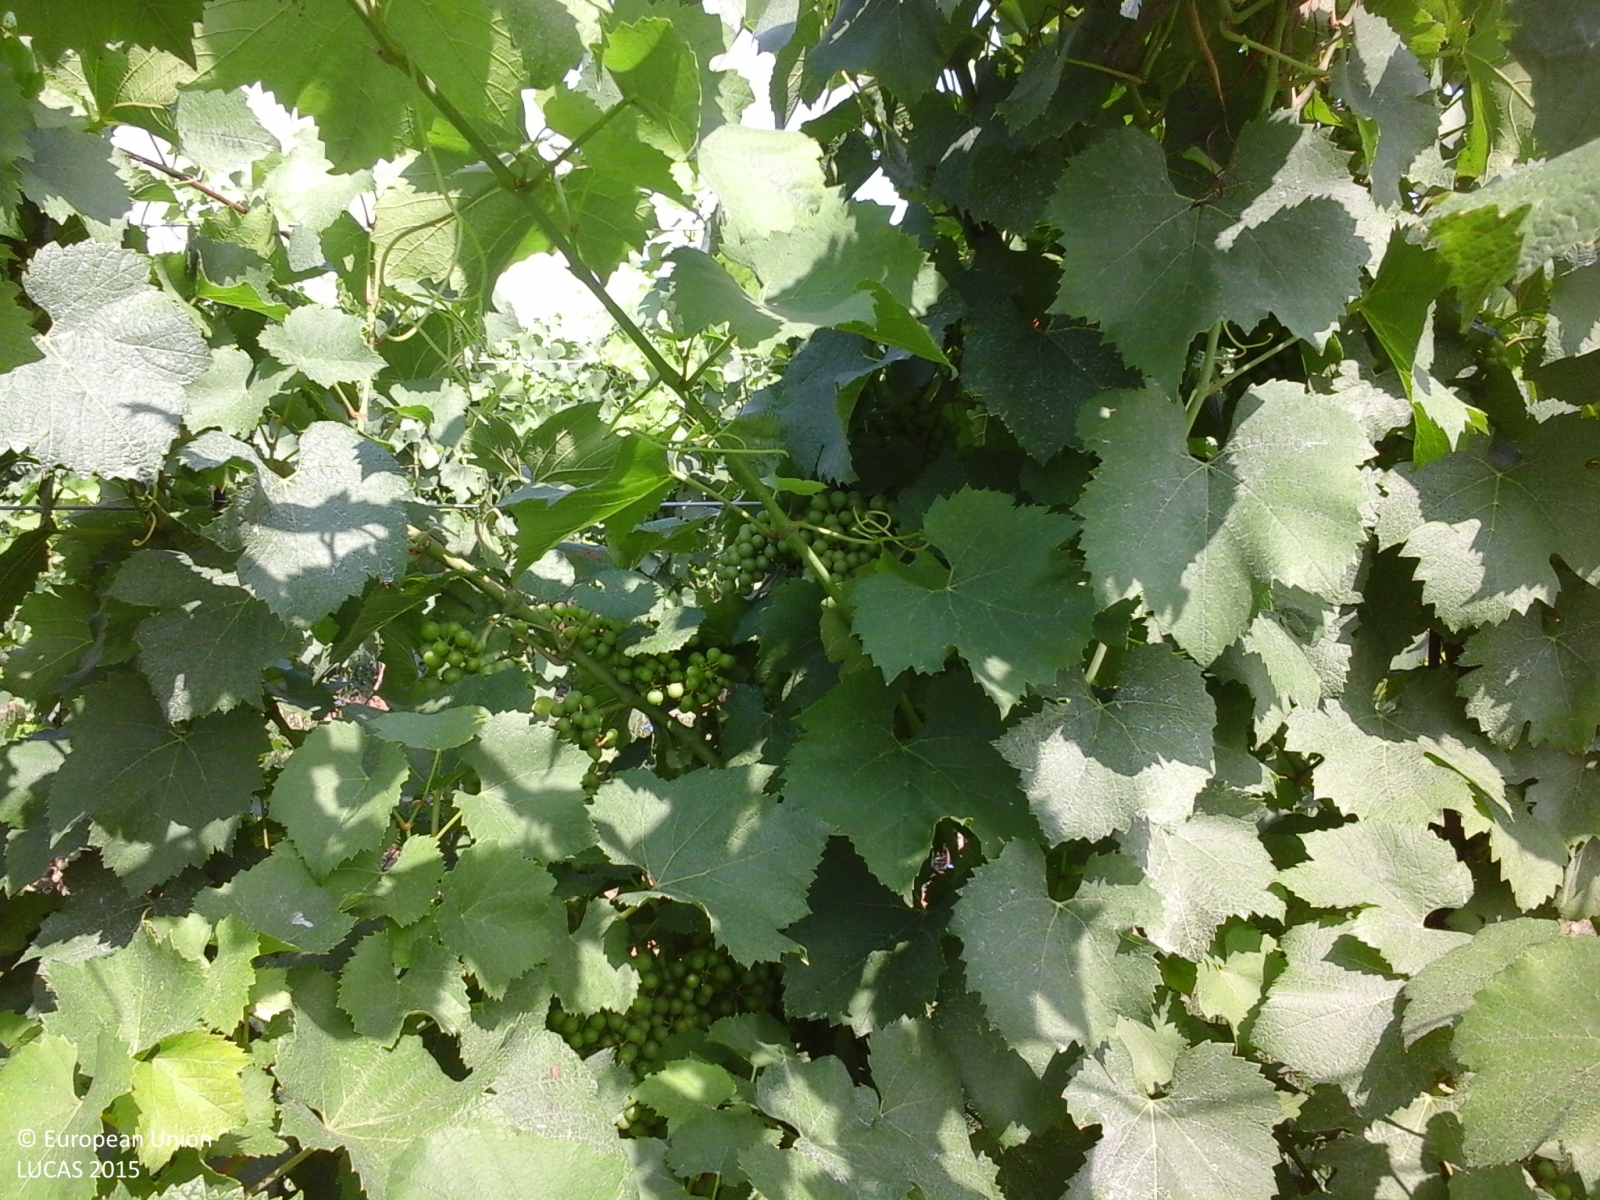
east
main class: Cropland
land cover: Vineyards
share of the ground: 50 - 75 %
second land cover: Grassland without tree/shrub cover
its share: > 75 %
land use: Agriculture (excluding fallow land and kitchen gardens)
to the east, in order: Vineyards; Grassland without tree/shrub cover; Tracks; Electric lines; Ditches and canals; Vineyards; Electric lines; Vineyards; Grass margins; Tracks; Grass margins; Vineyards; Grass margins; Paved roads, cycling and walking lanes
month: June
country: IT
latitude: 45.2989
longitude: 11.2348
